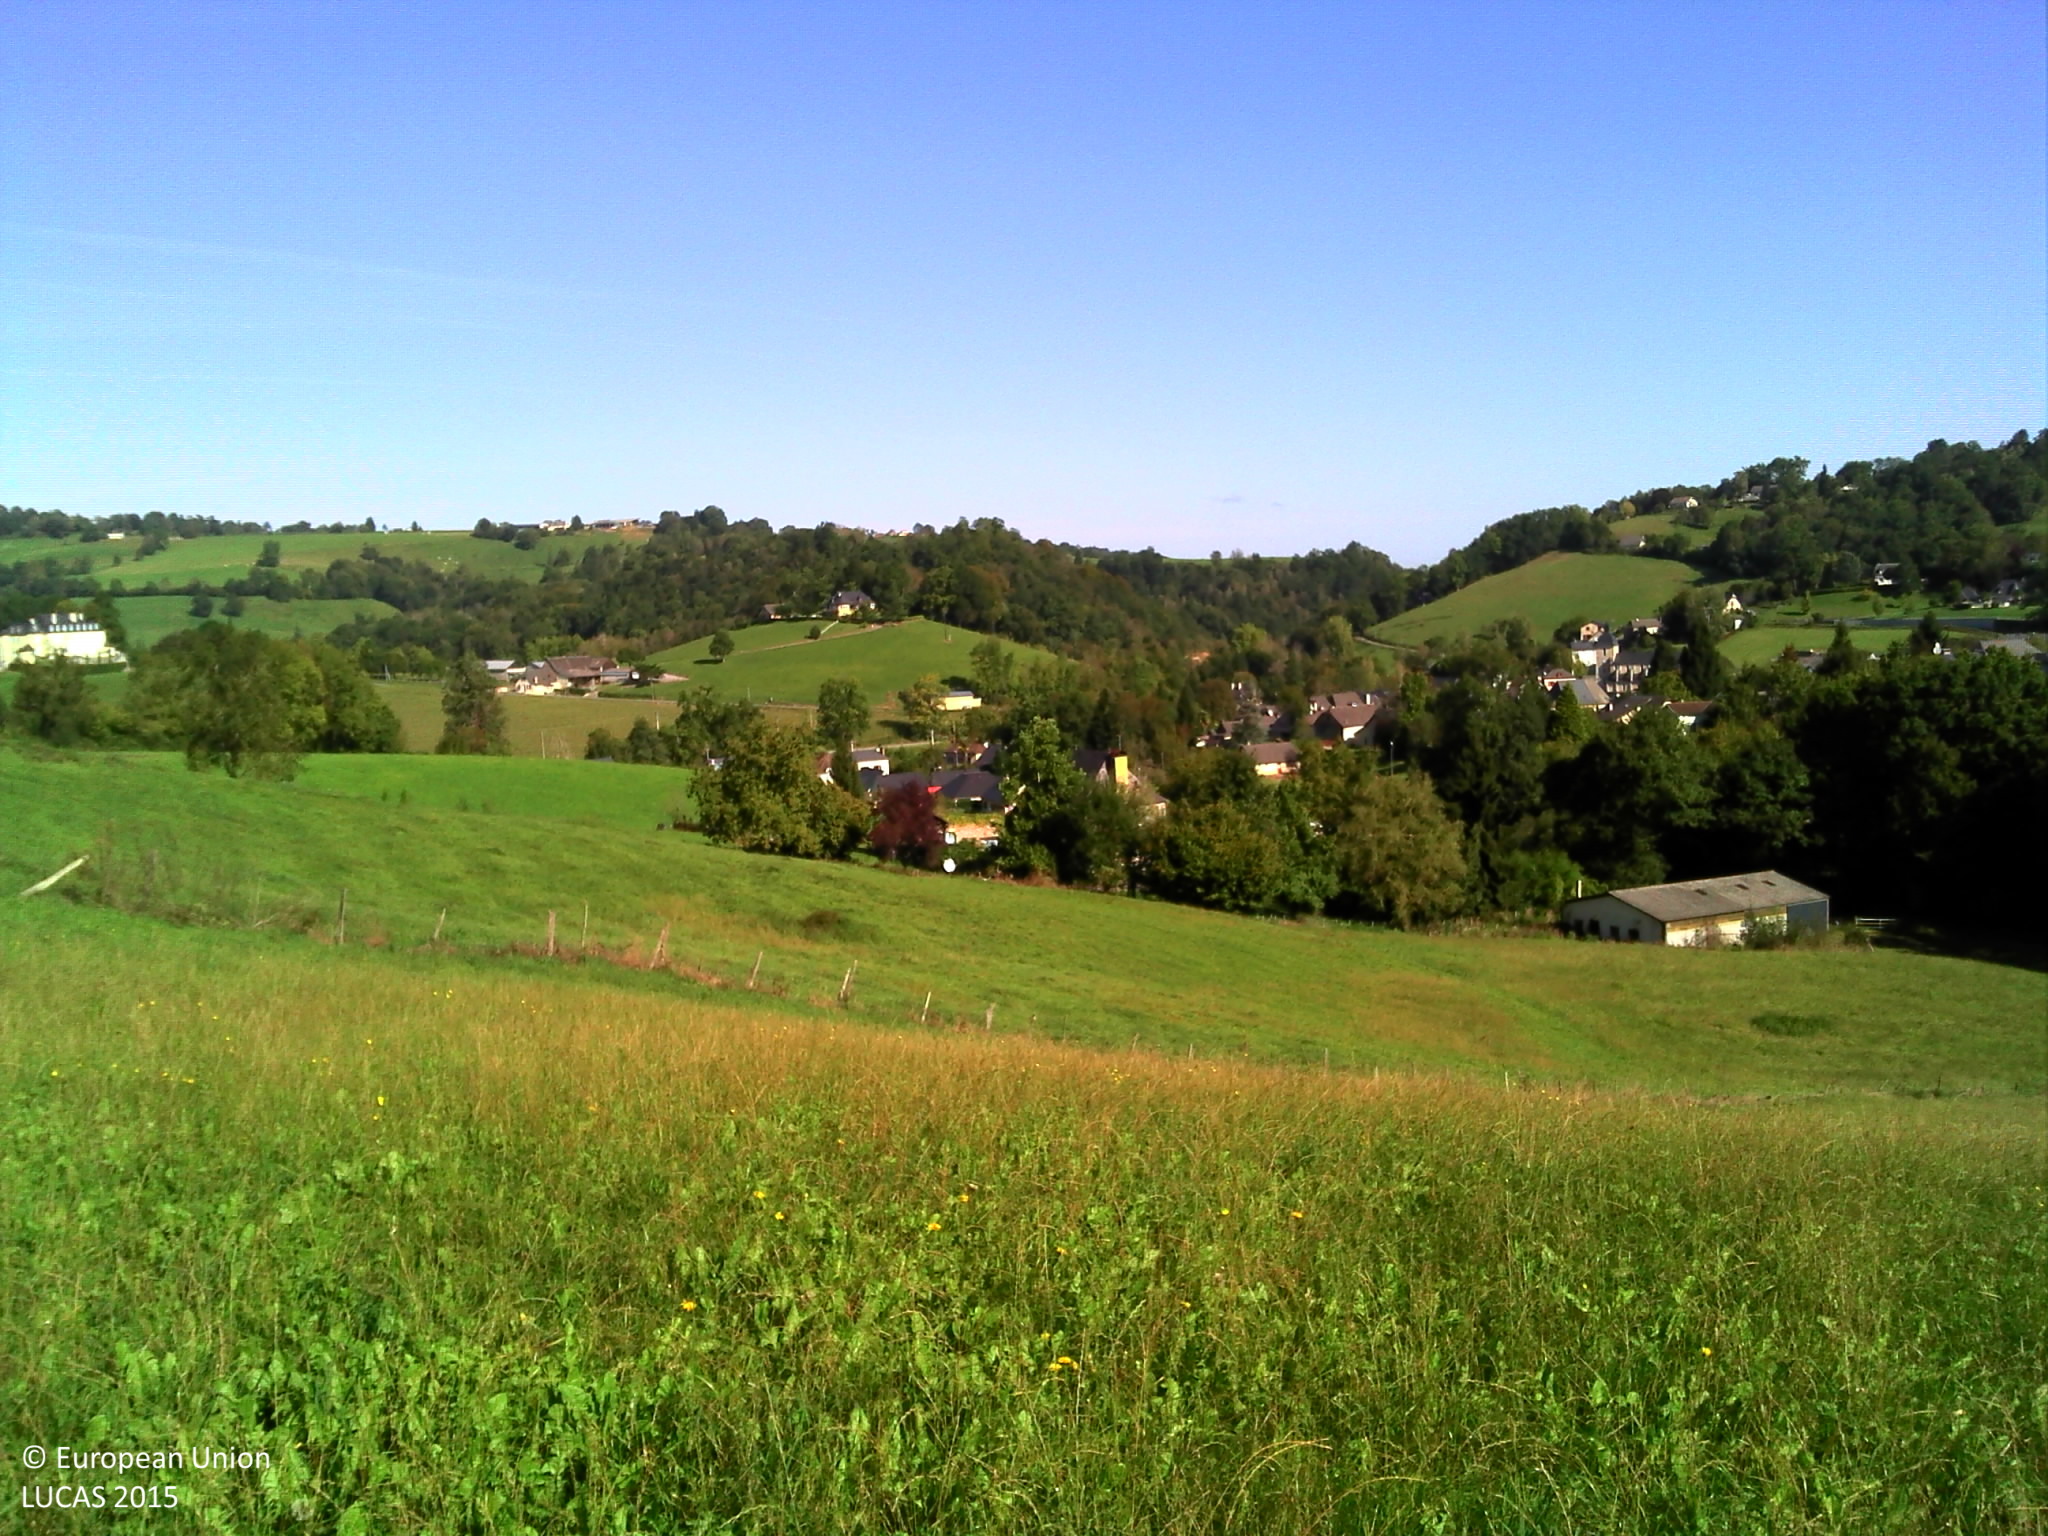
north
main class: Grassland
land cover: Grassland without tree/shrub cover
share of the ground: > 75 %
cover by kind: herbaceous plants 100 %
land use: Agriculture (excluding fallow land and kitchen gardens)
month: September
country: FR
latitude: 43.1543
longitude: -0.3974
